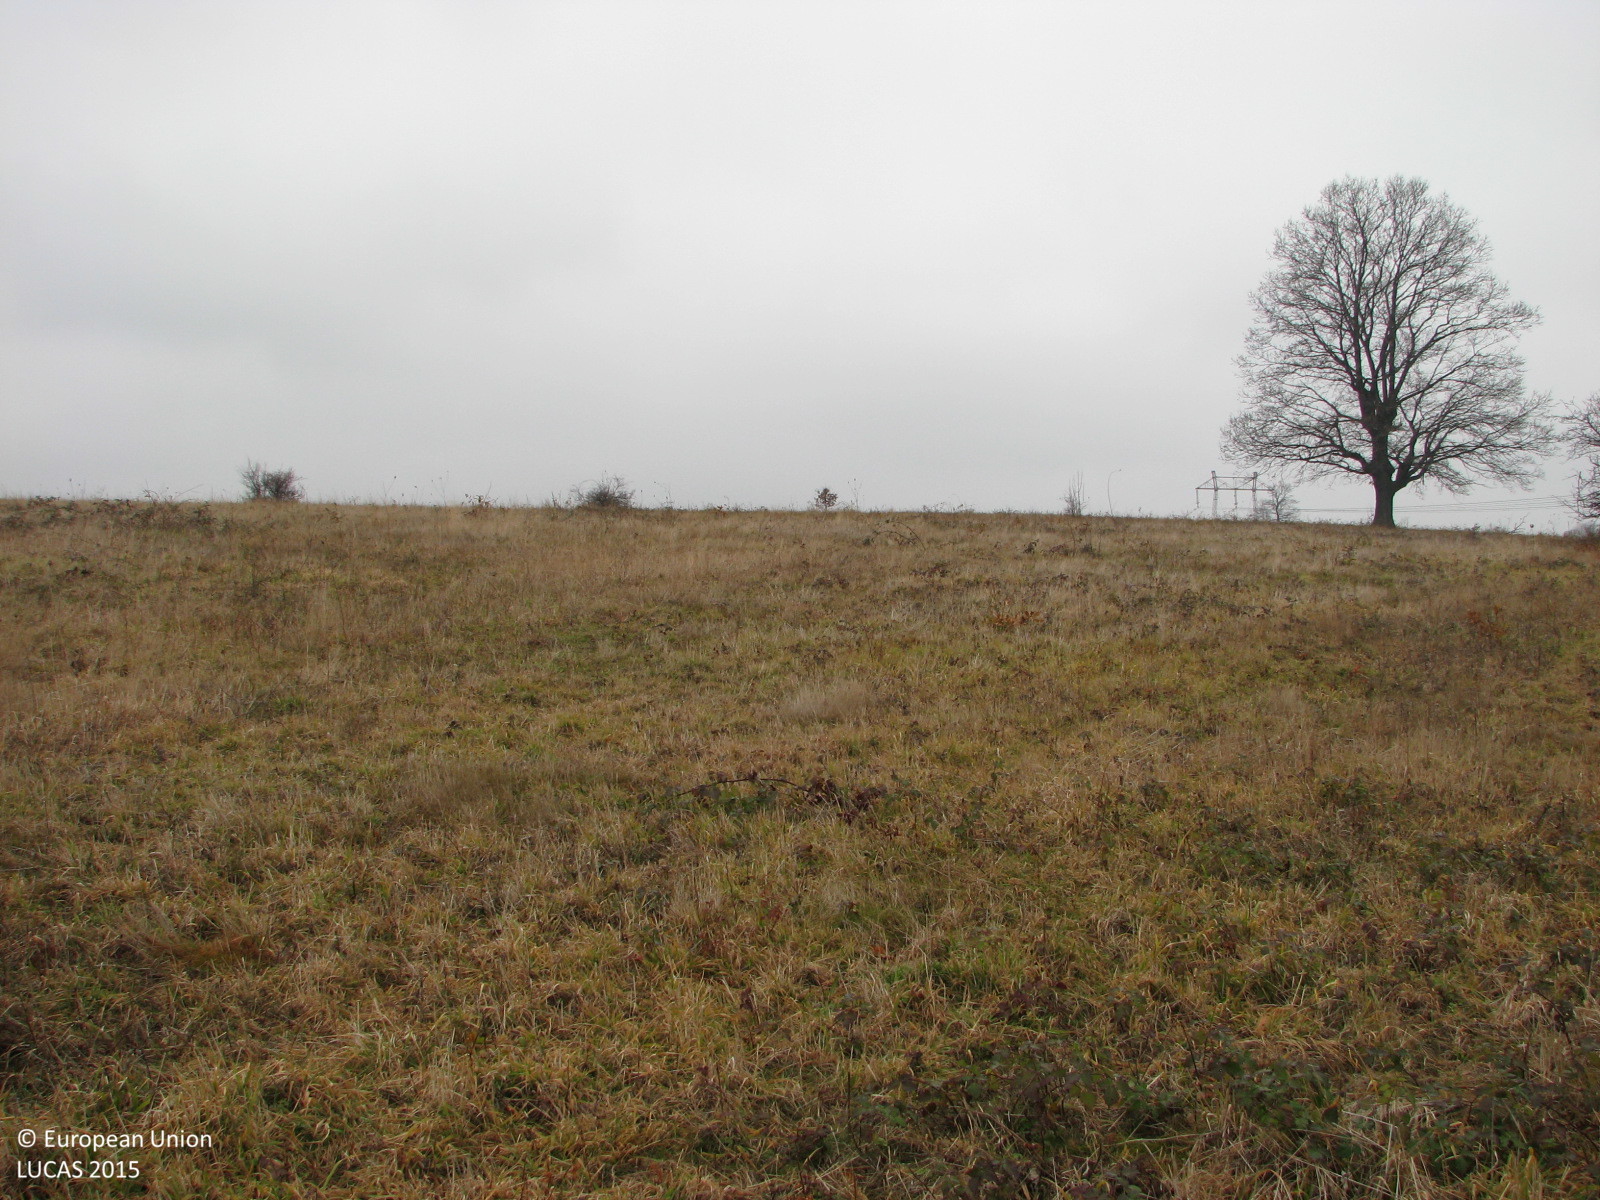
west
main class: Grassland
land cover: Grassland without tree/shrub cover
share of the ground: > 75 %
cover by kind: herbaceous plants 100 %
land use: Agriculture (excluding fallow land and kitchen gardens)
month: December
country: BG
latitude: 42.2374
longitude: 23.9135
